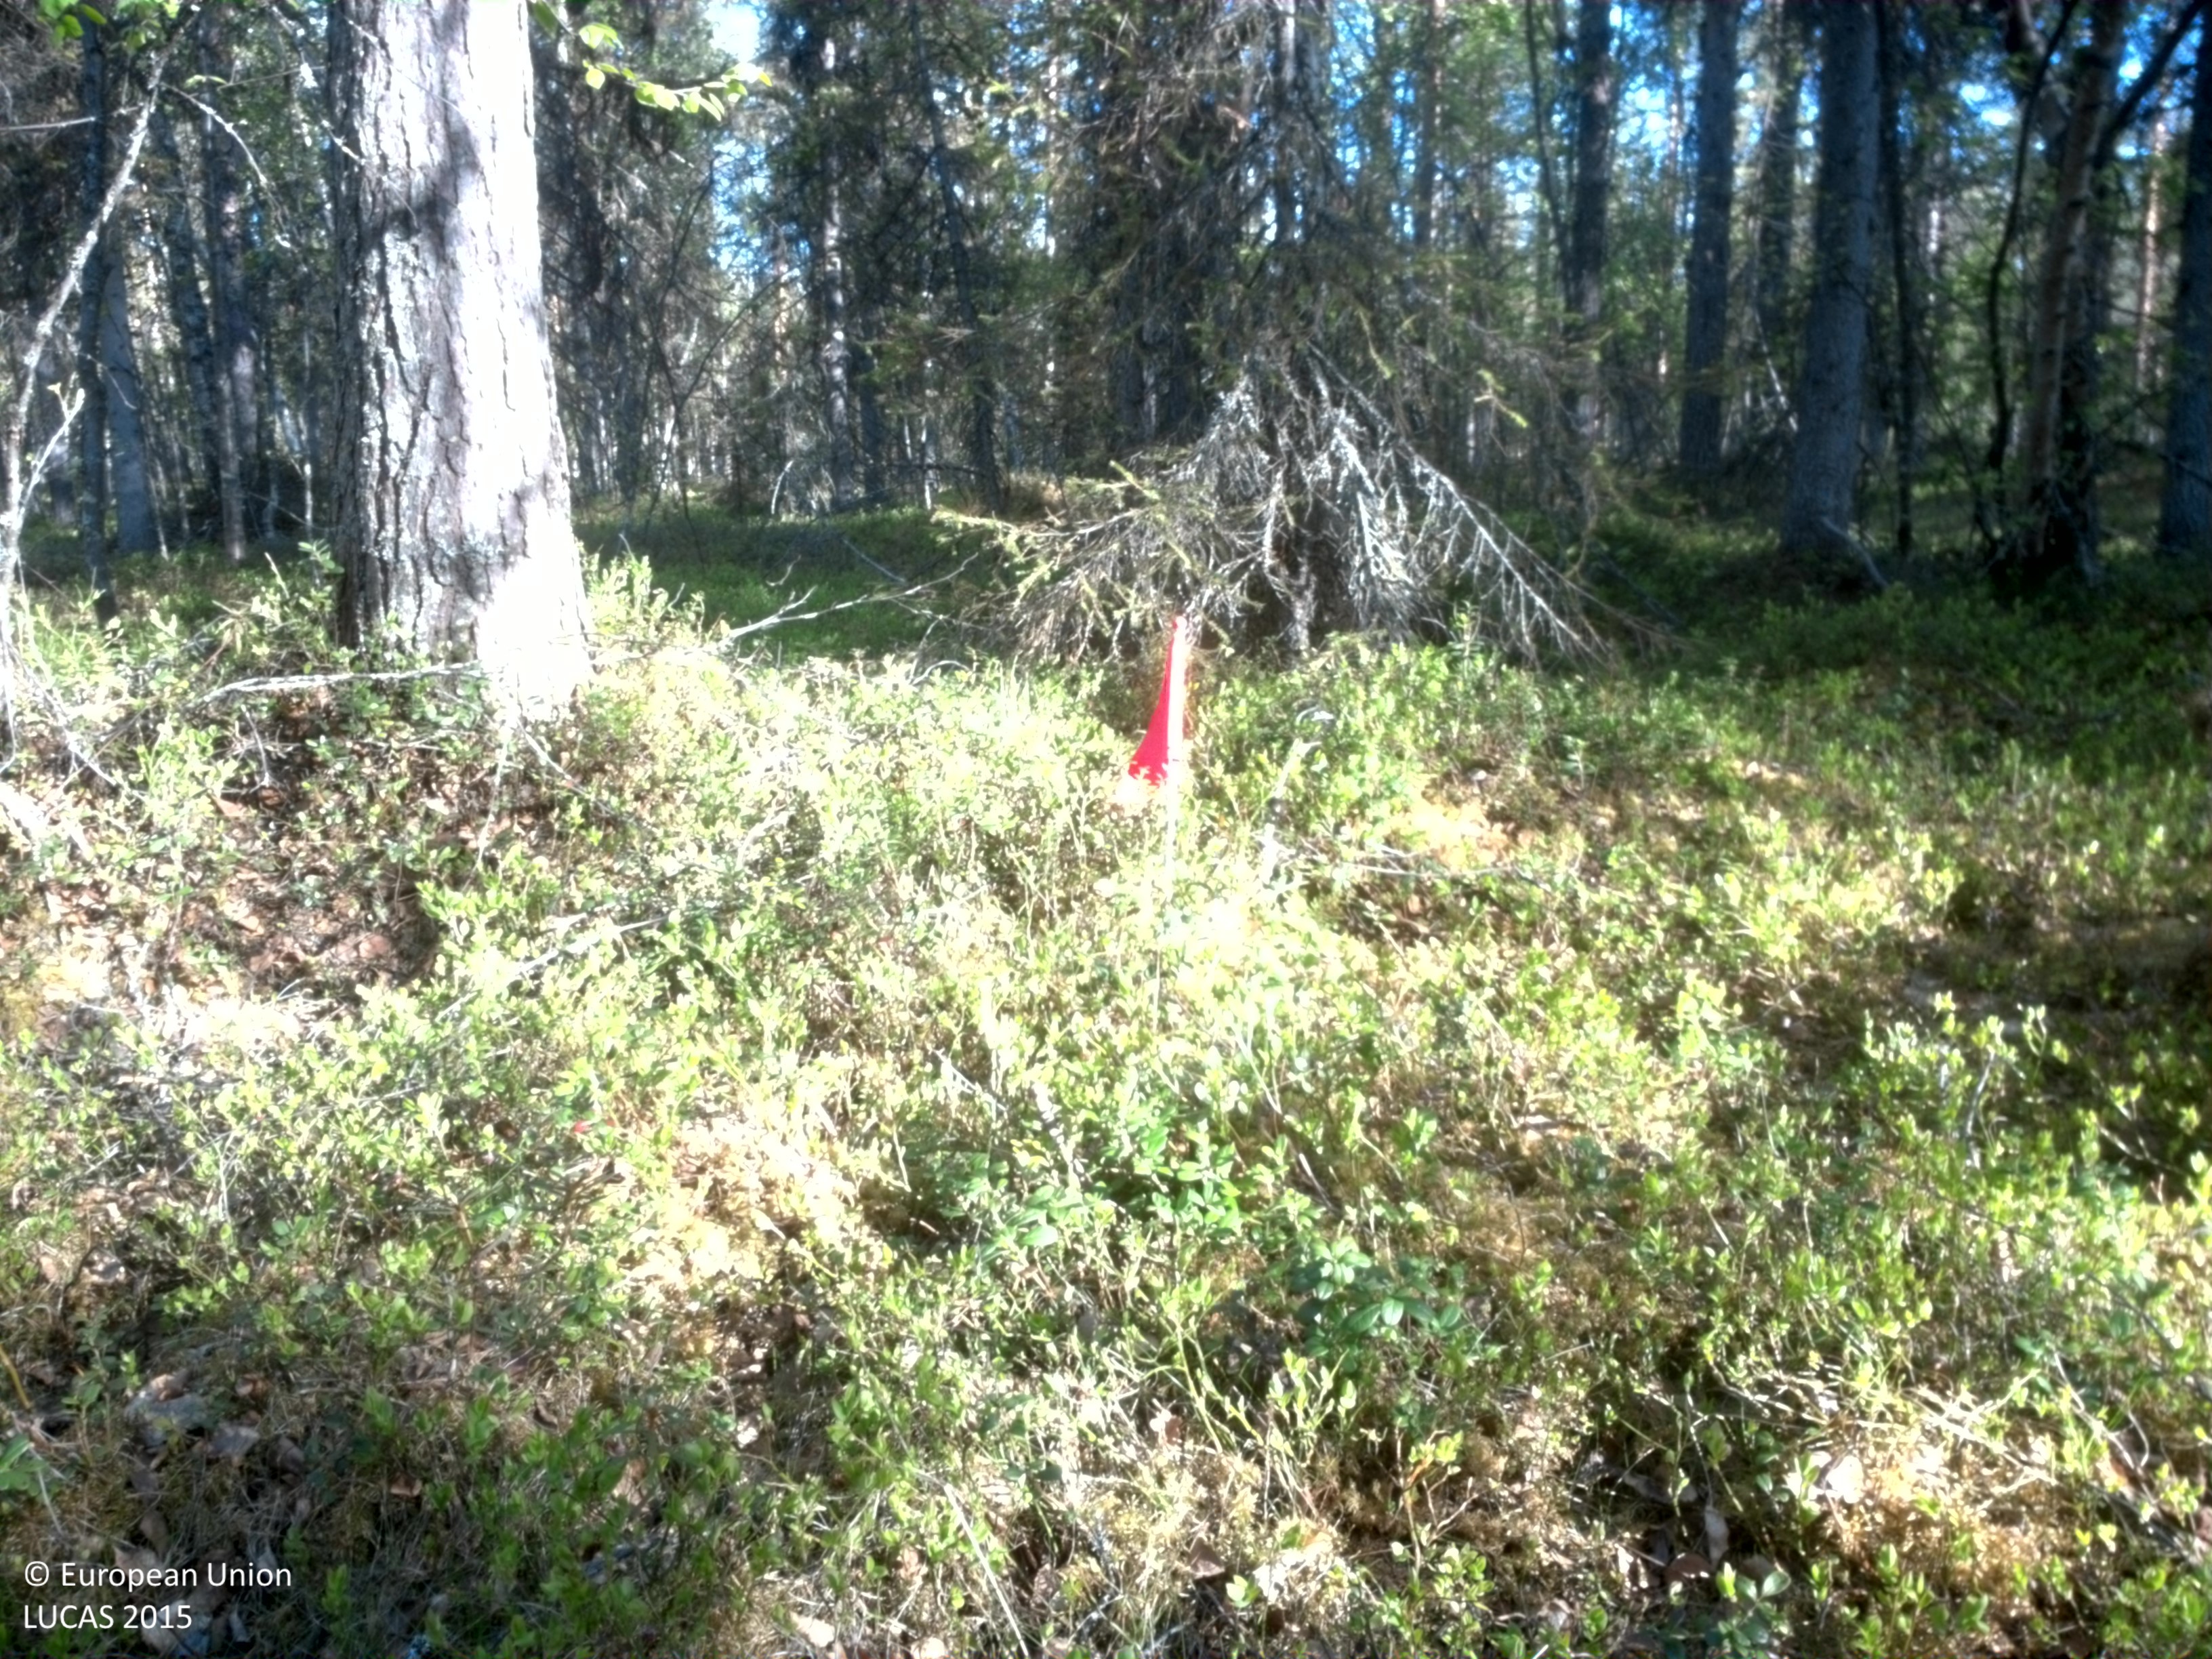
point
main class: Woodland
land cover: Other mixed woodland
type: boreal forest
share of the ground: 25 - 50 %
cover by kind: shrubs 50 %, coniferous forest trees 30 %, broadleaved forest trees 15 %, lichens and mosses 5 %
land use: Forestry
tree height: > 5 m
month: June
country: SE
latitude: 67.0696
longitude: 21.2931
